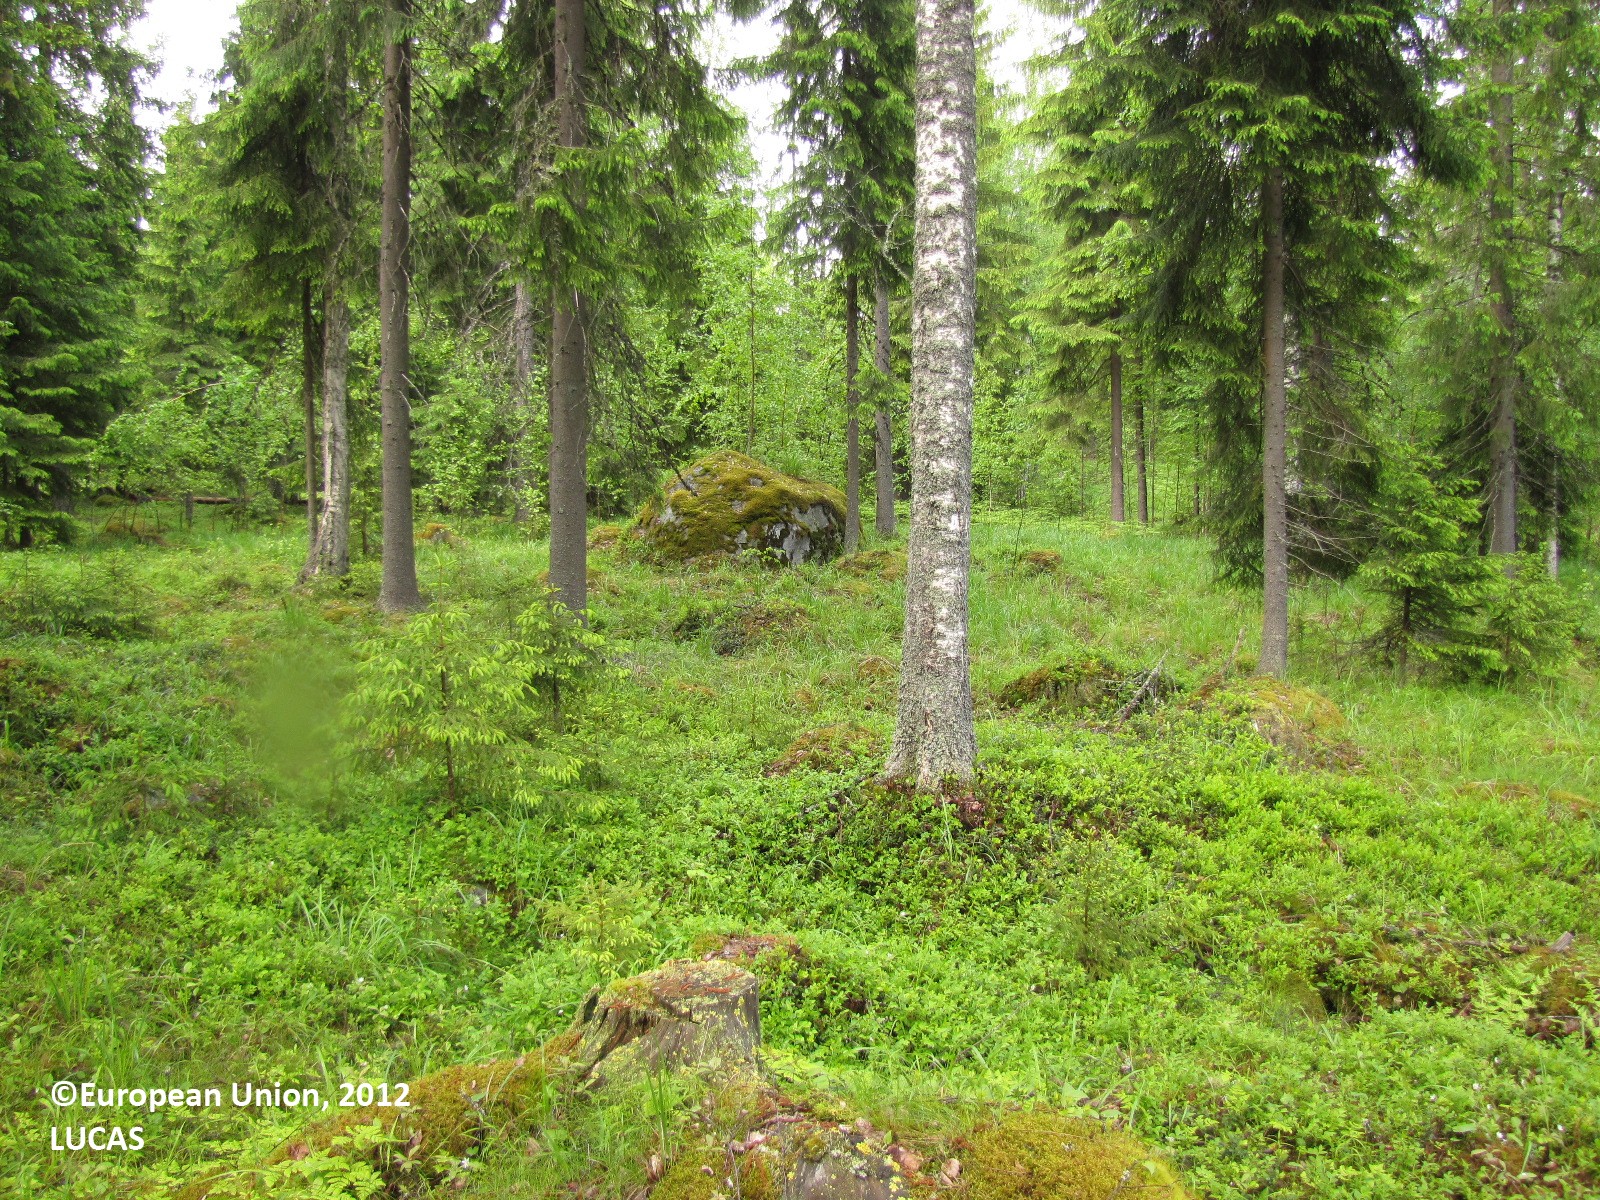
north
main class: Woodland
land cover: Spruce dominated coniferous woodland
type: boreal forest
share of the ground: > 75 %
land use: Forestry
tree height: > 5 m
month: June
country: FI
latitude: 61.2615
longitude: 23.5621
